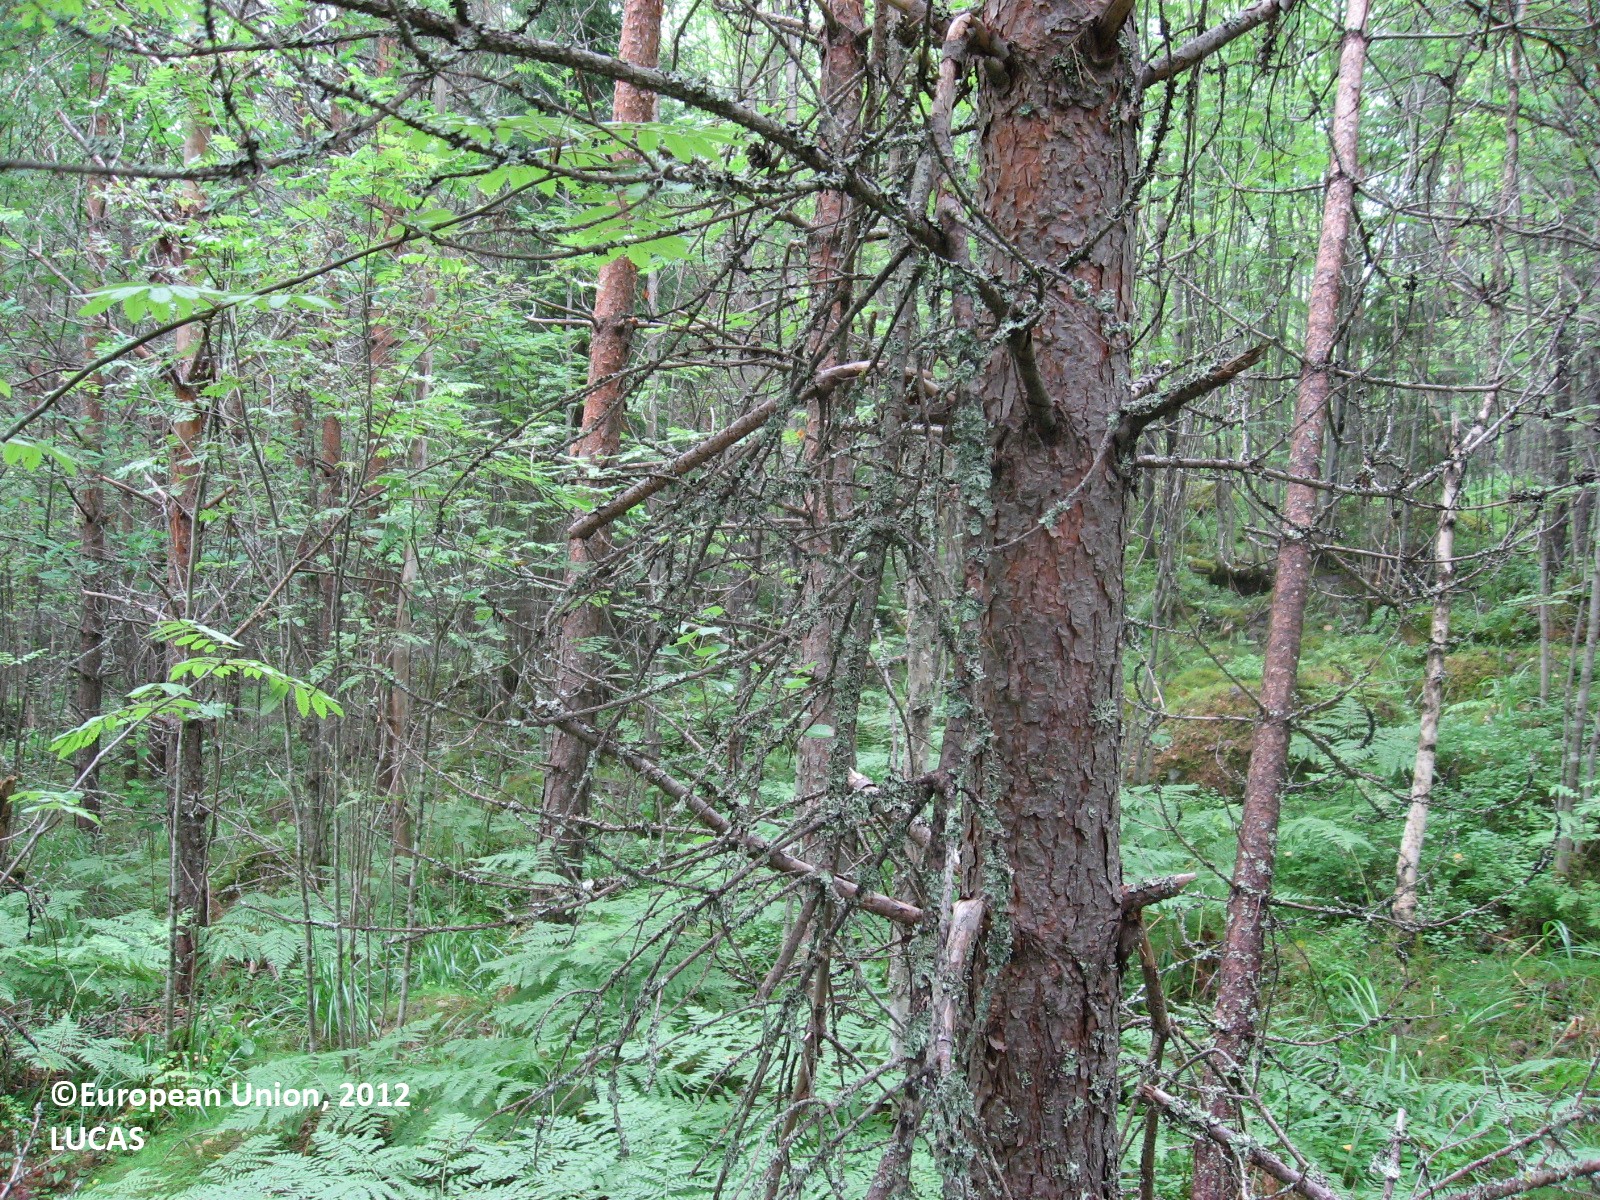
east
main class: Woodland
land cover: Pine dominated mixed woodland
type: boreal forest
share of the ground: > 75 %
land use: Forestry
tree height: > 5 m
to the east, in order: Pine dominated mixed woodland; Spruce dominated coniferous woodland; Tracks; Spruce dominated coniferous woodland; Ditches and canals; Spruce dominated mixed woodland; Ditches and canals; Spruce dominated mixed woodland
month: July
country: FI
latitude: 61.0698
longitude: 25.7913
